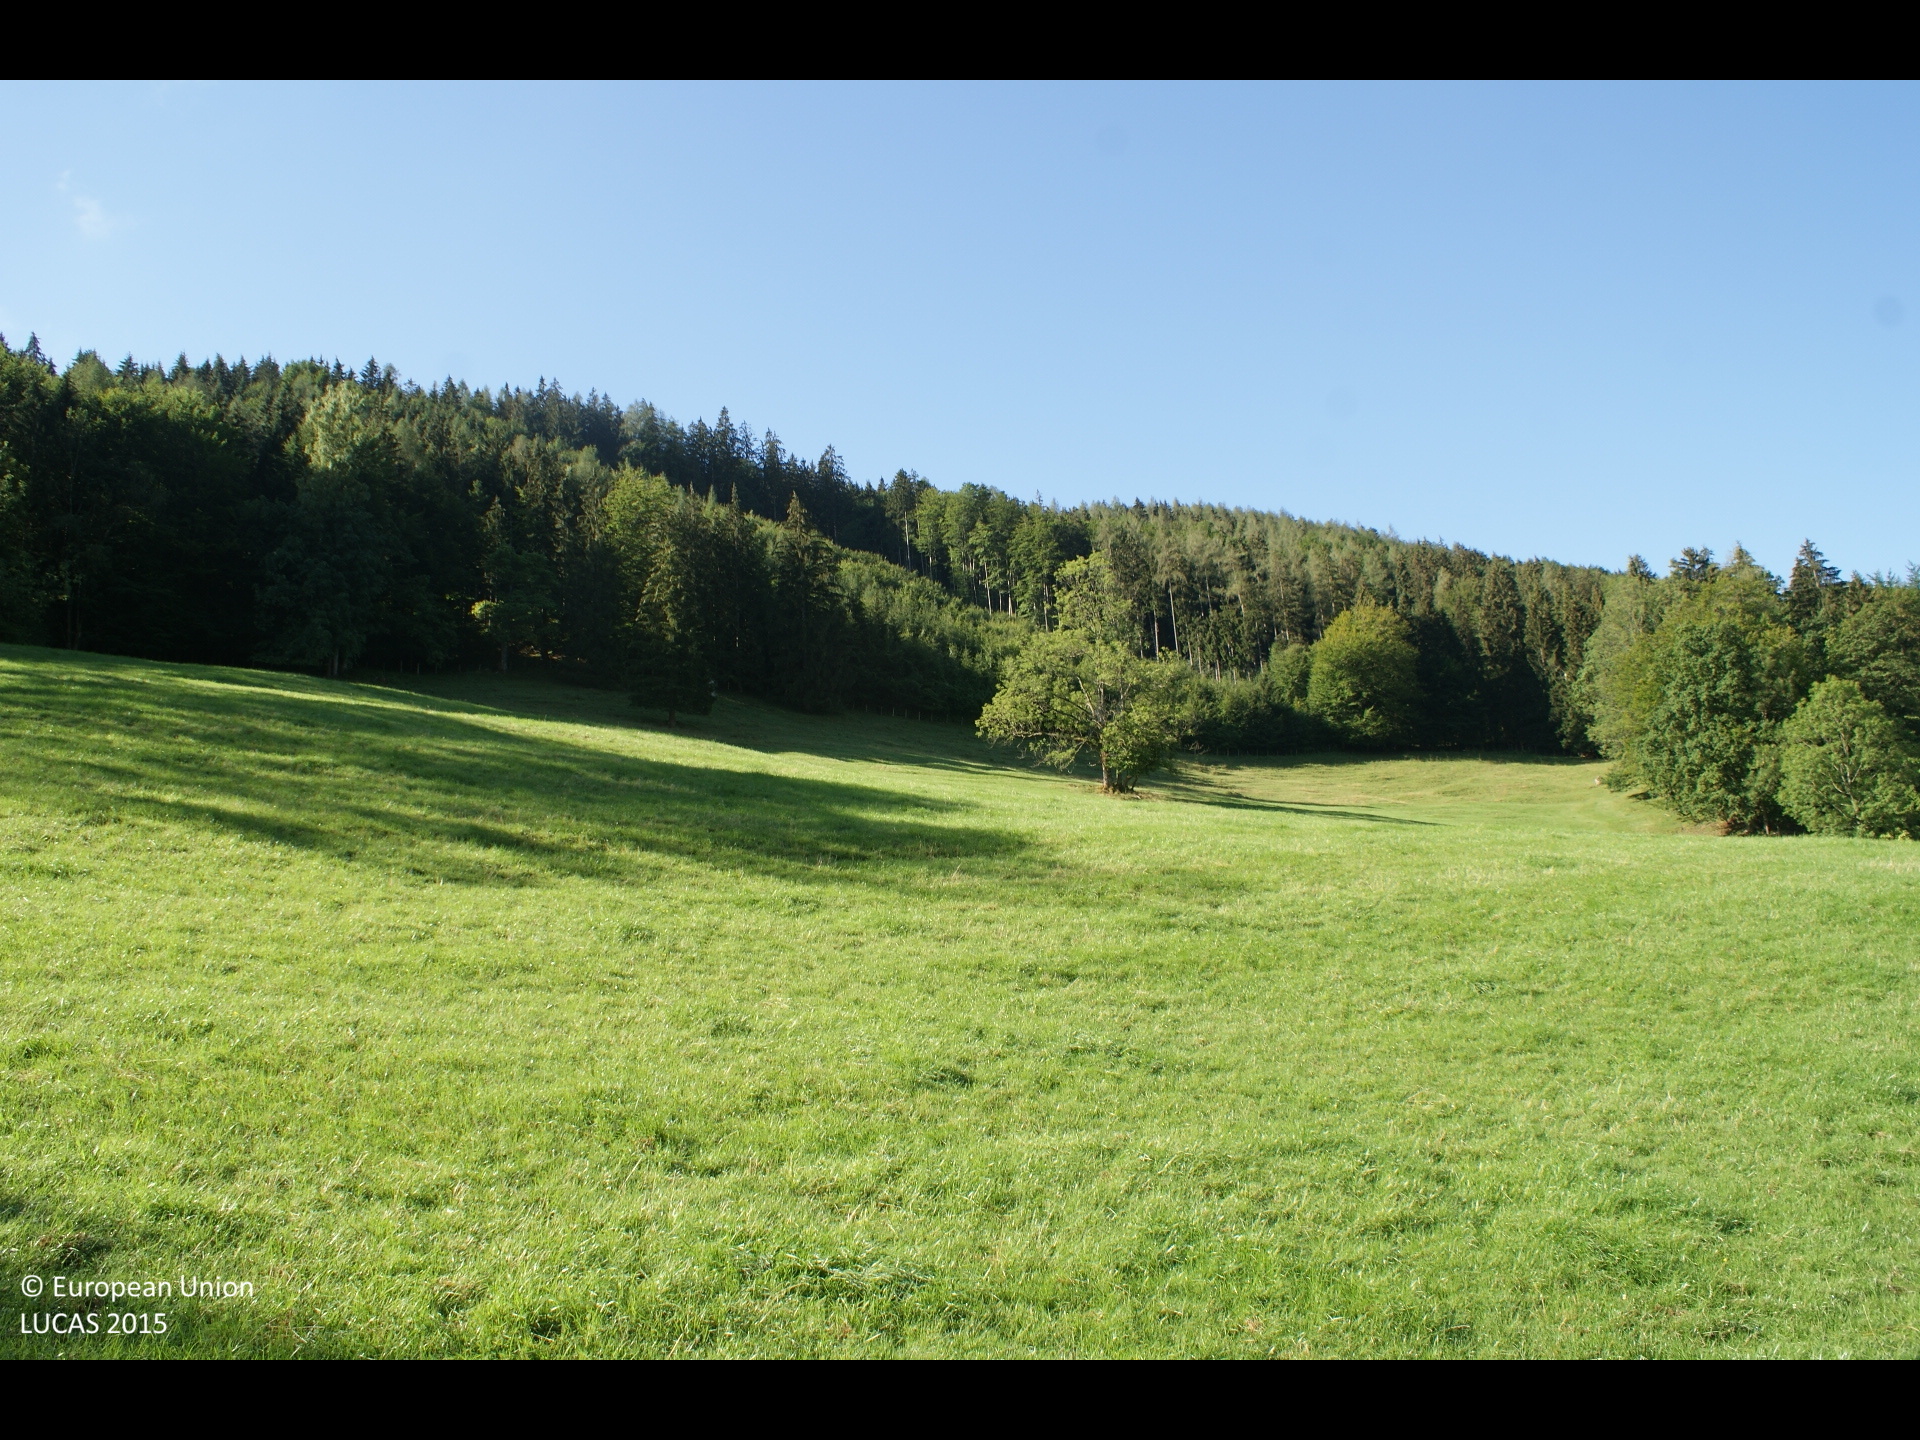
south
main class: Grassland
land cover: Grassland without tree/shrub cover
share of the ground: > 75 %
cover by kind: herbaceous plants 100 %
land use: Agriculture (excluding fallow land and kitchen gardens)
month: August
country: AT
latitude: 47.9205
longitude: 14.8045
